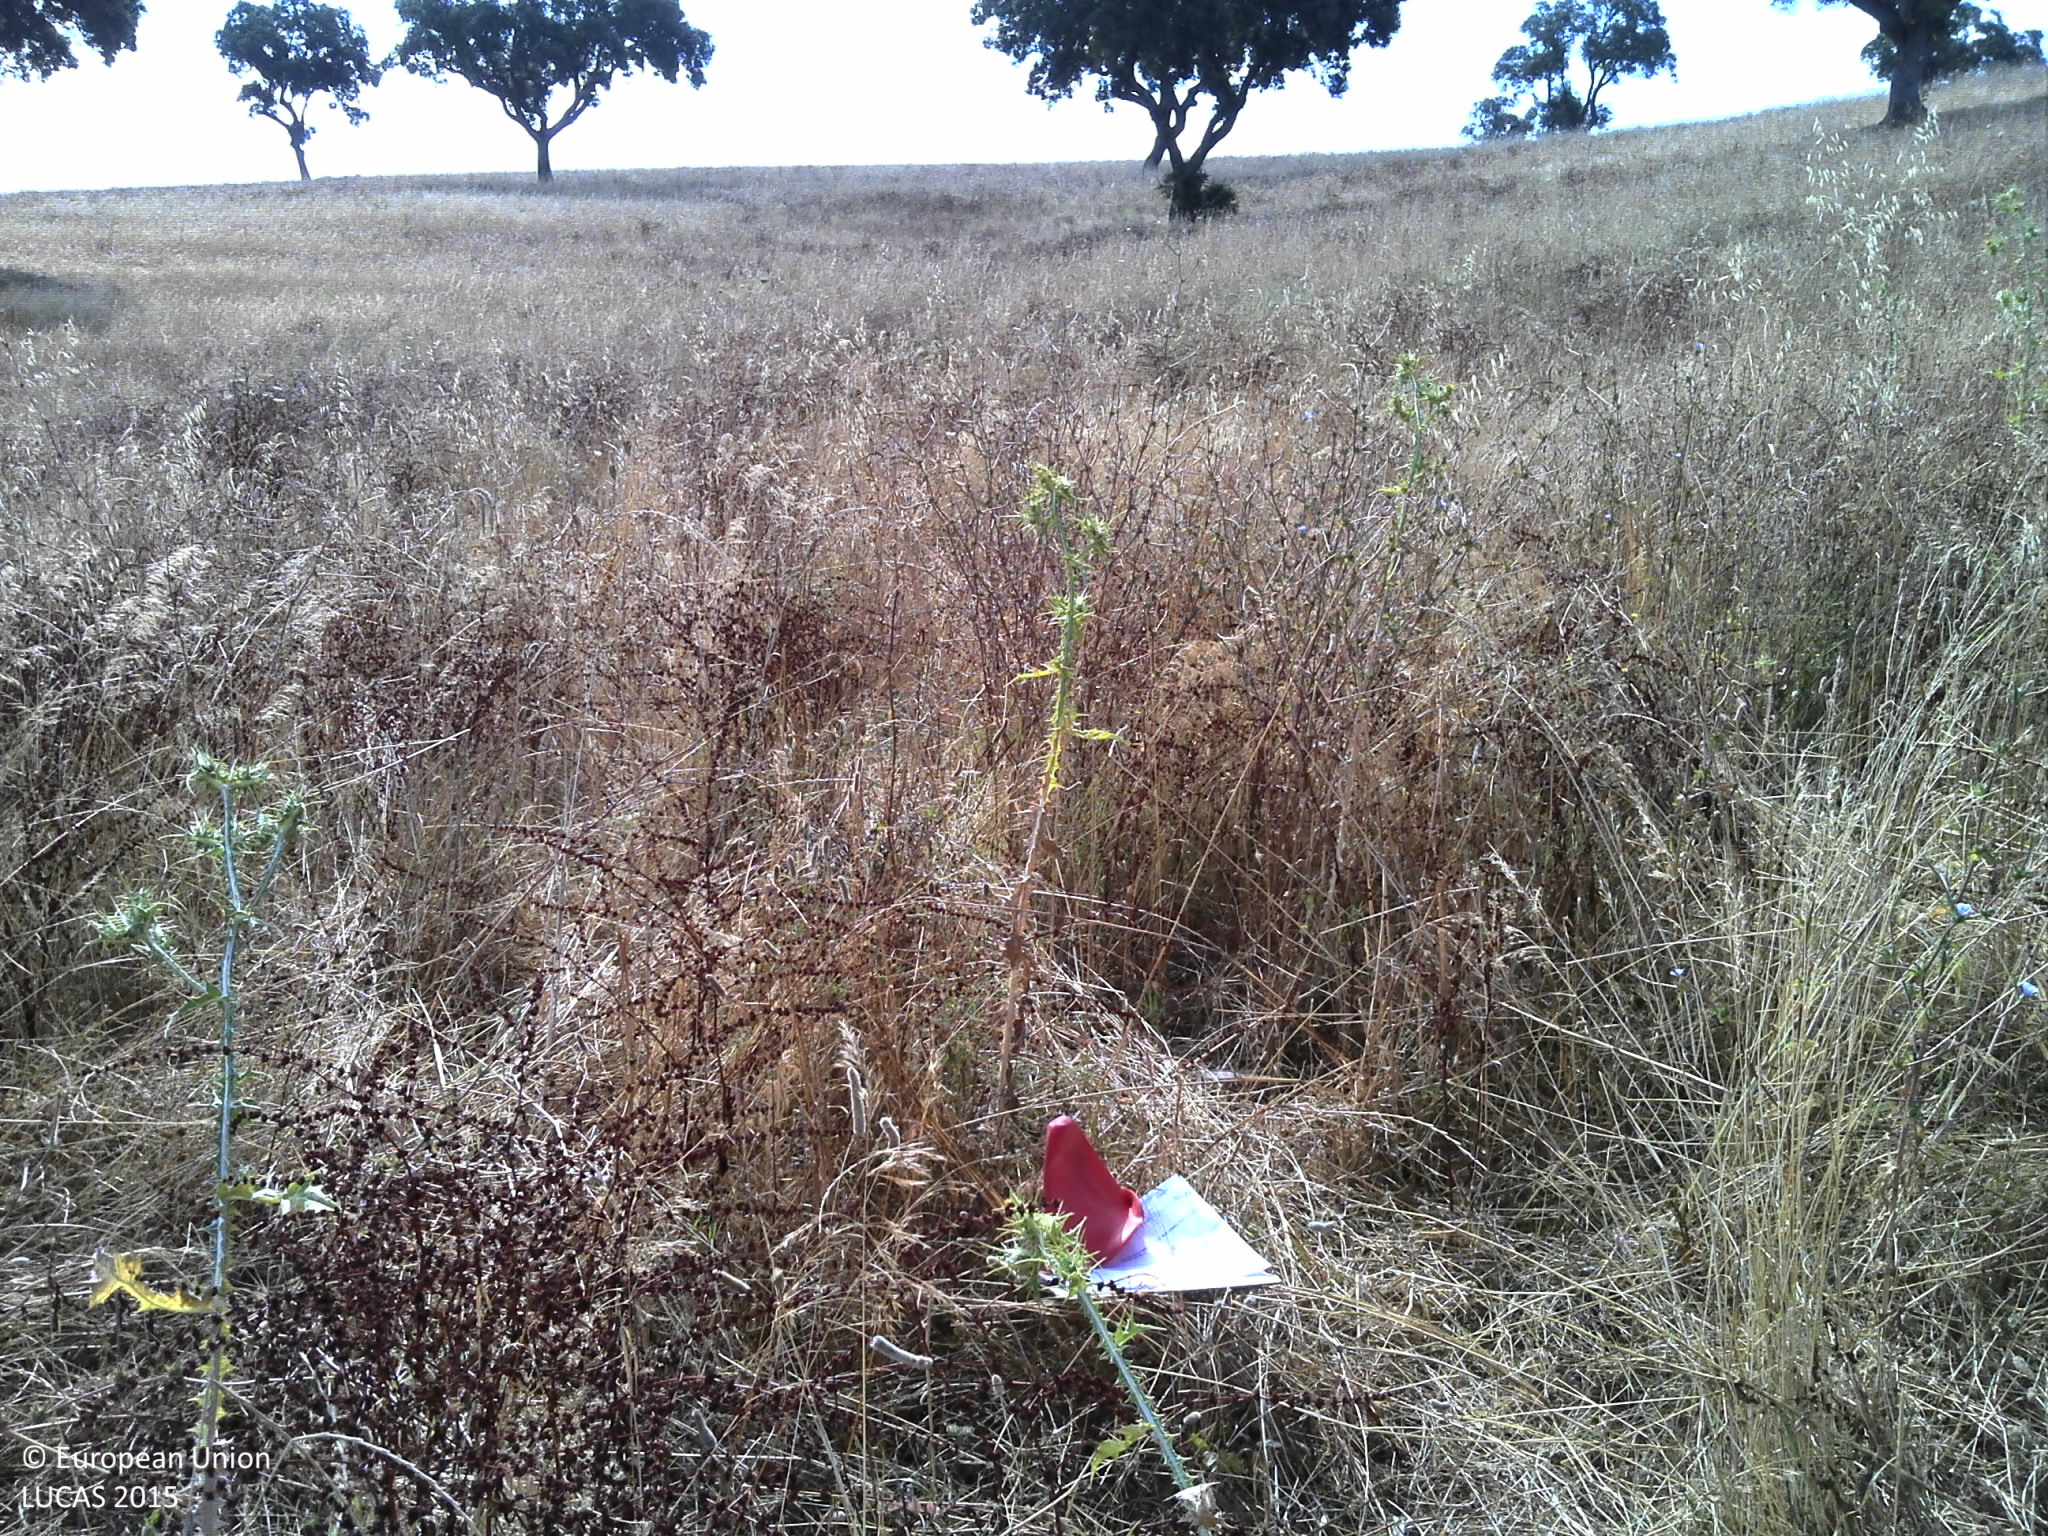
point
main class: Grassland
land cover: Grassland without tree/shrub cover
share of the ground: > 75 %
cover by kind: herbaceous plants 90 %, unconsolidated bare surface 10 %
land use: Agriculture (excluding fallow land and kitchen gardens)
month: June
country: PT
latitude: 37.8321
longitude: -8.2699
